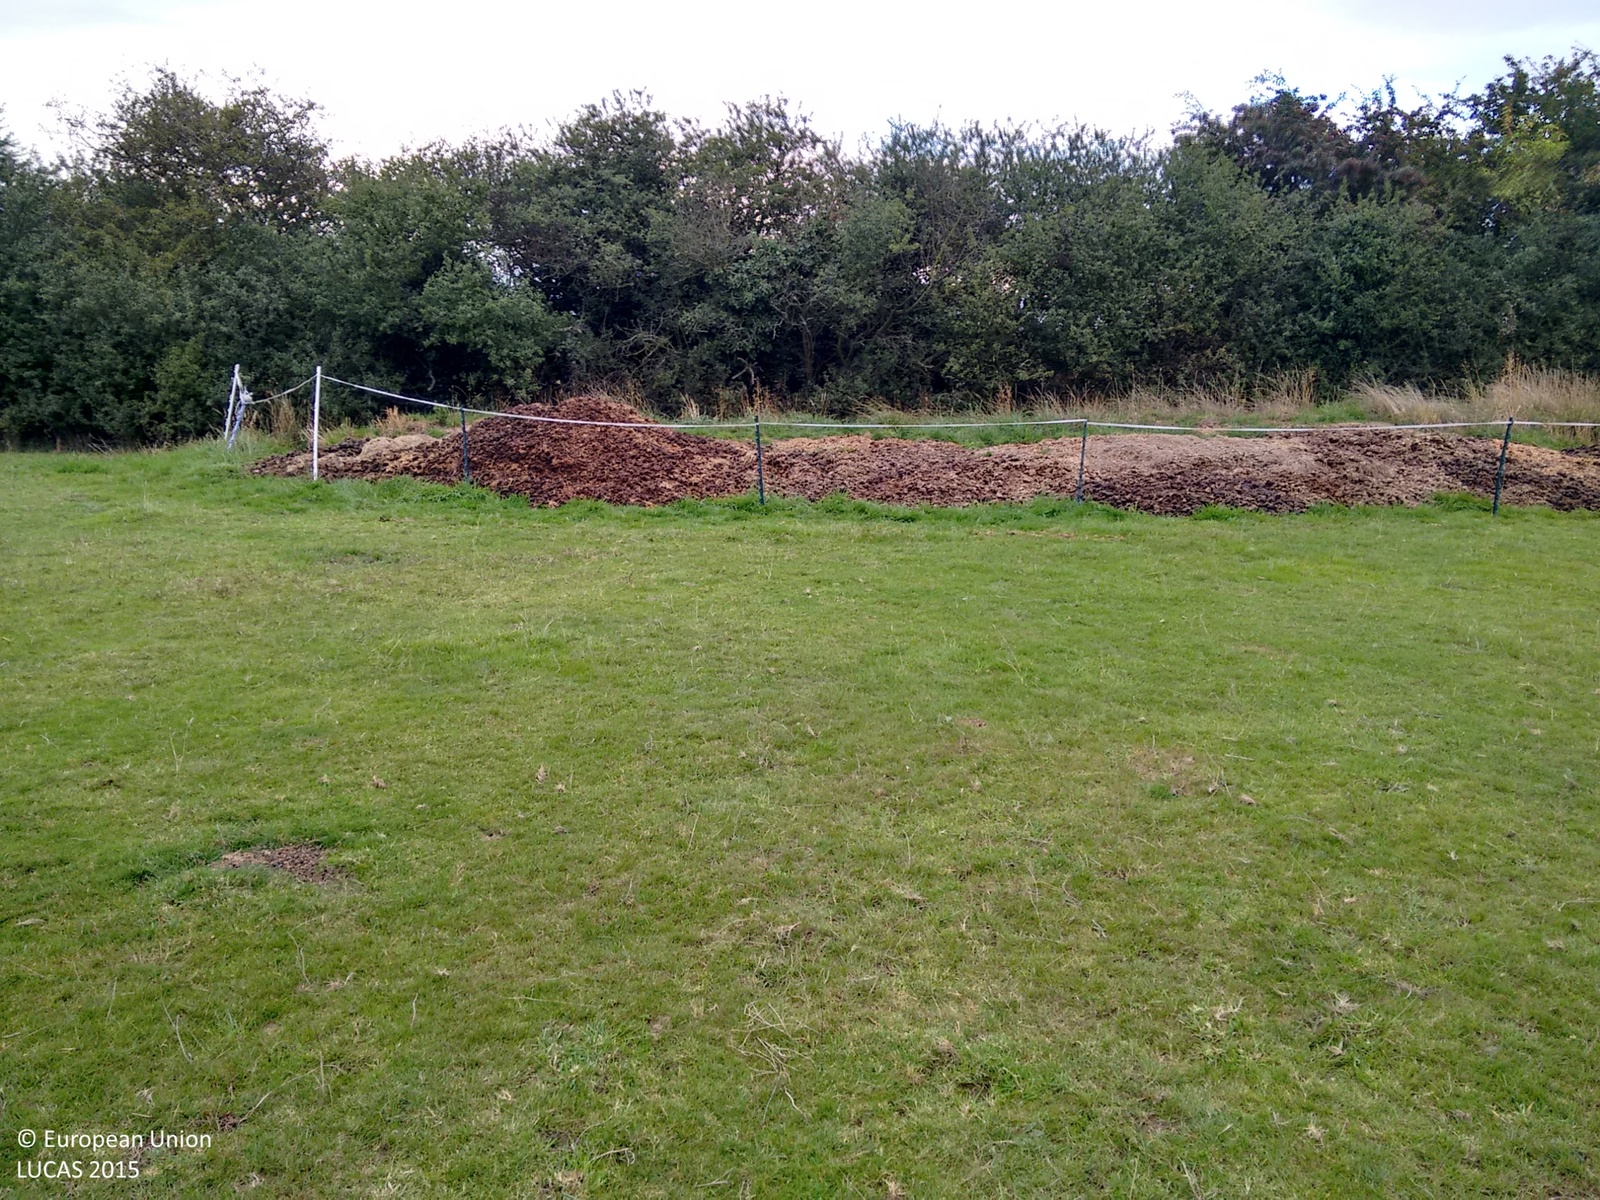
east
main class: Grassland
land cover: Grassland without tree/shrub cover
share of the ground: > 75 %
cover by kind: herbaceous plants 100 %
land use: Agriculture (excluding fallow land and kitchen gardens)
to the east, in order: Grassland without tree/shrub cover; Fences; Managed hedges; Grass margins; Common wheat
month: September
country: GB
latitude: 52.5592
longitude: -1.3328
